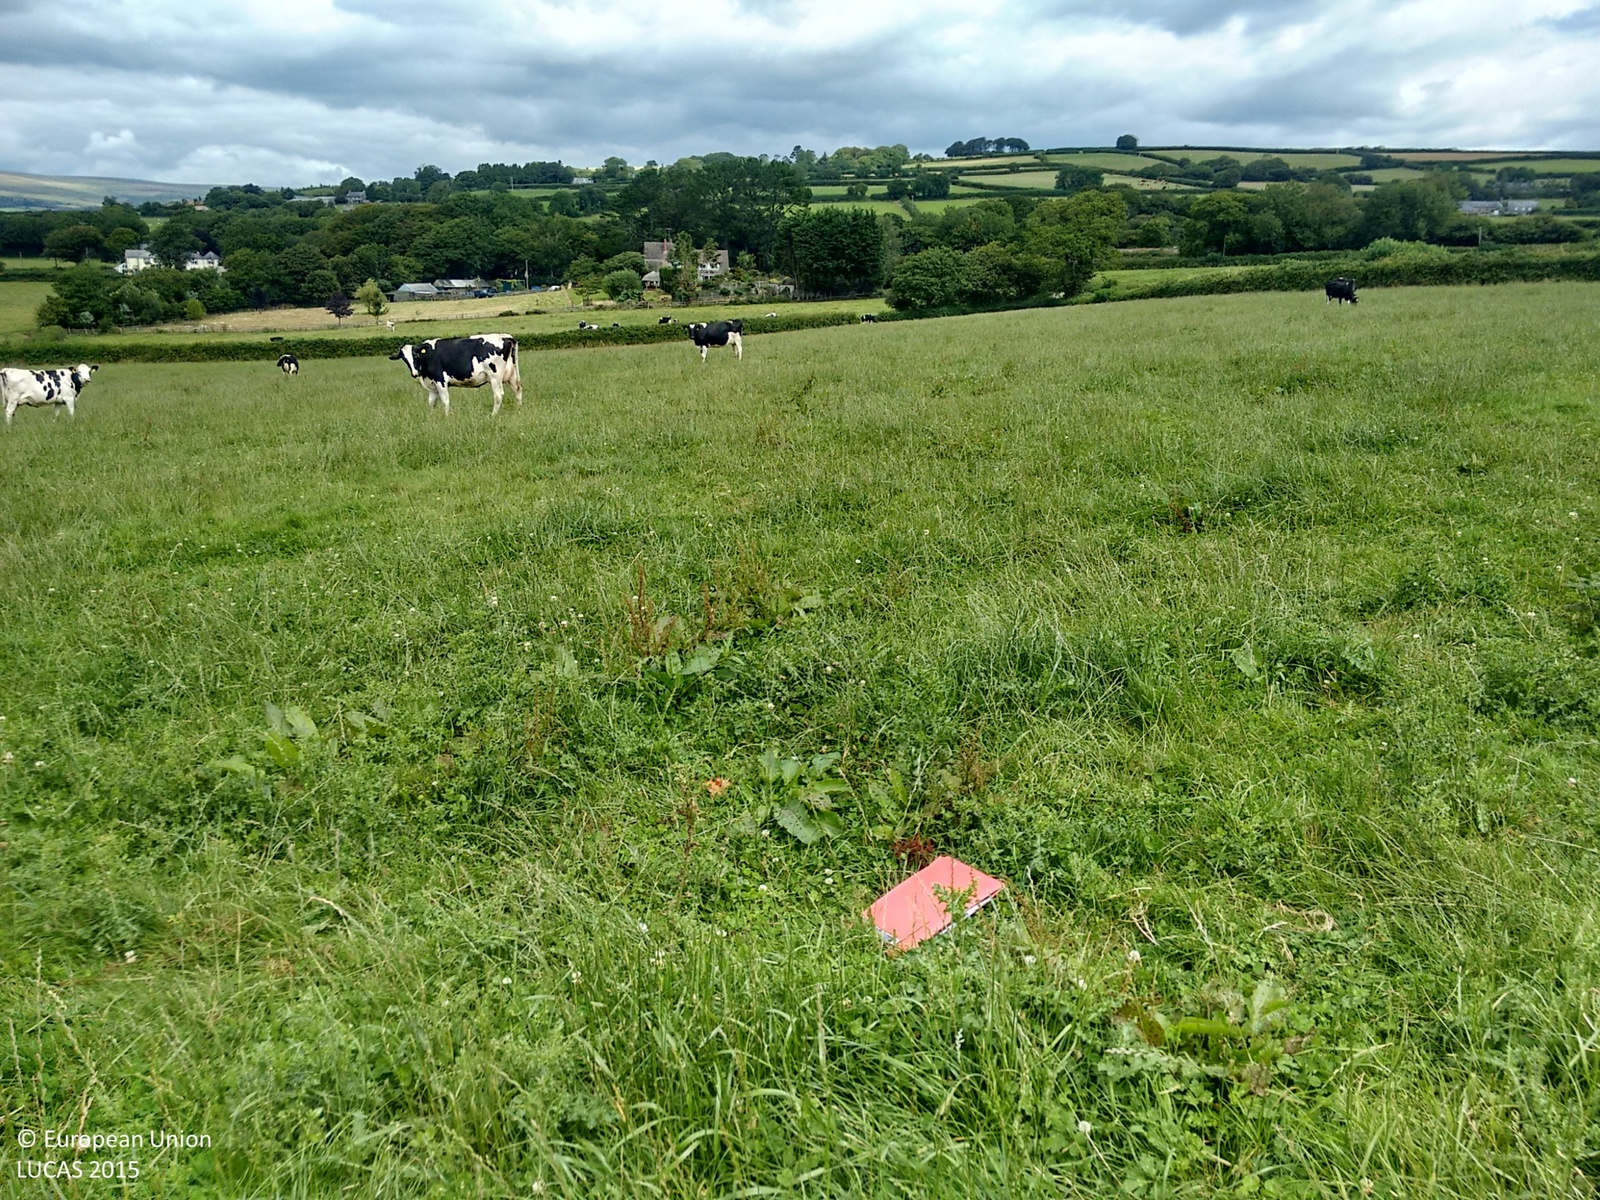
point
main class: Grassland
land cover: Grassland without tree/shrub cover
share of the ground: > 75 %
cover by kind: herbaceous plants 100 %
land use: Agriculture (excluding fallow land and kitchen gardens)
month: August
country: GB
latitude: 50.3983
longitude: -3.9495
